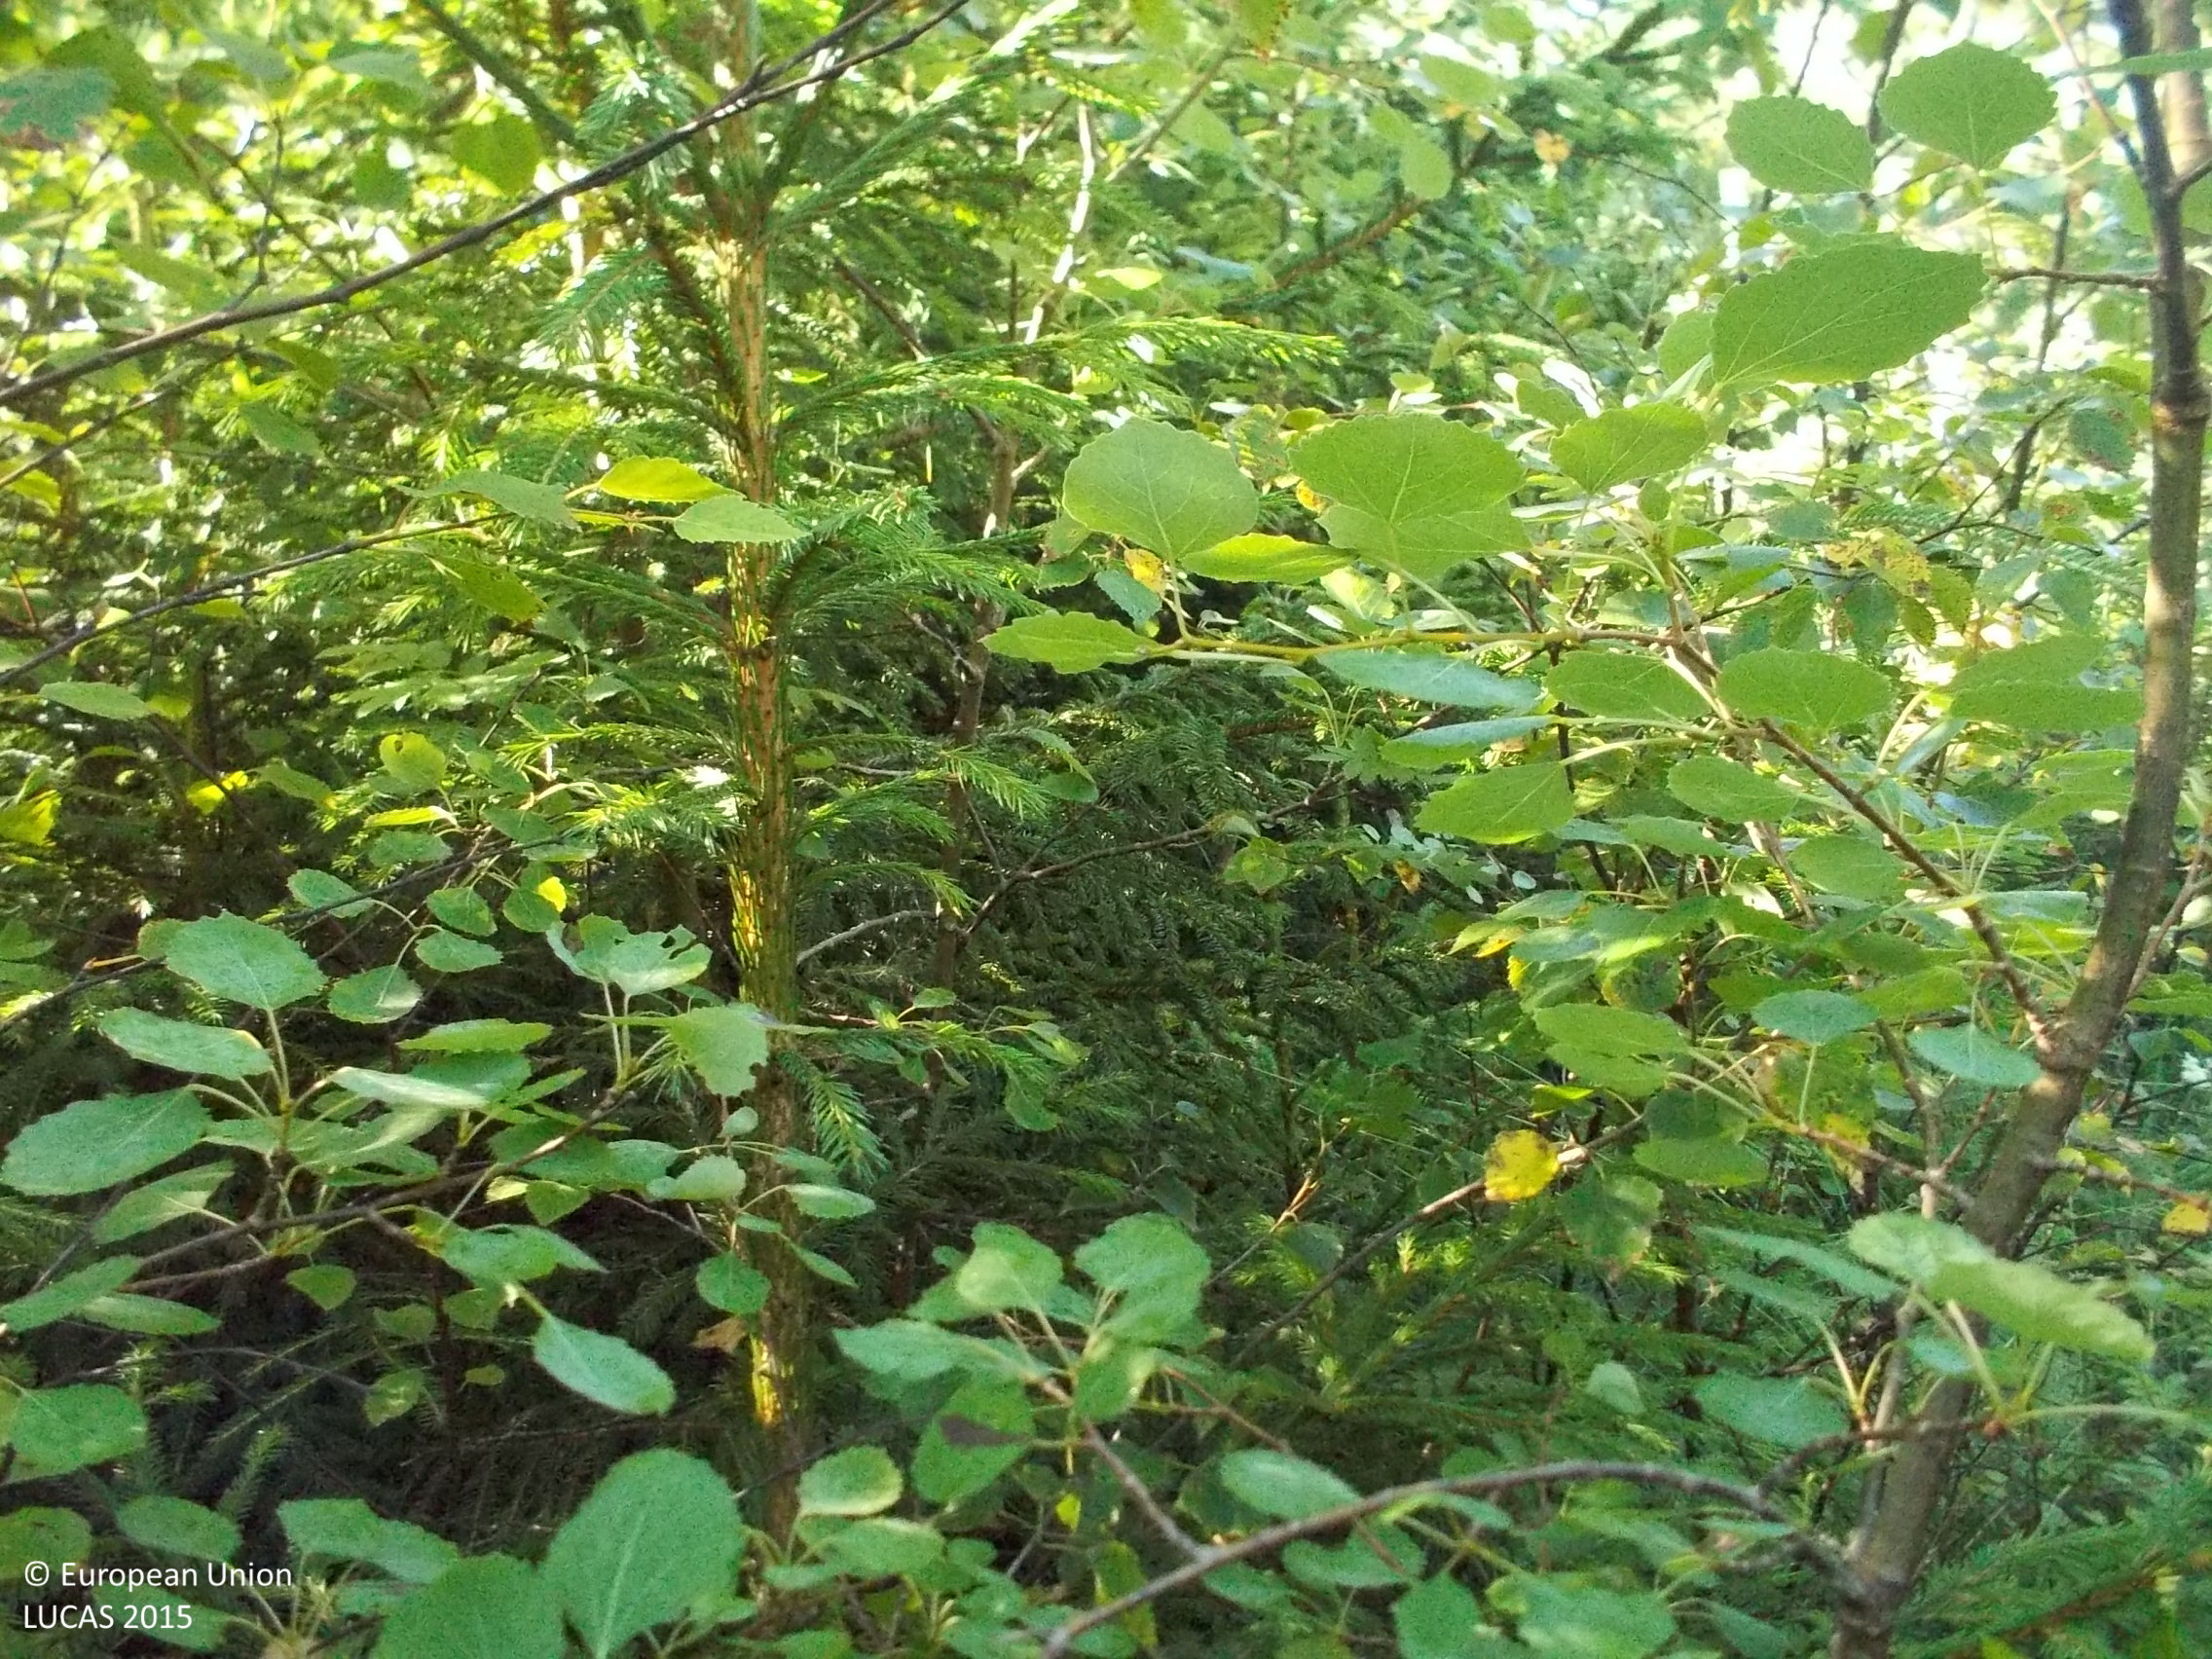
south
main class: Woodland
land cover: Spruce dominated mixed woodland
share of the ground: > 75 %
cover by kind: broadleaved forest trees 60 %, coniferous forest trees 30 %, herbaceous plants 10 %
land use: Forestry
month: August
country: SE
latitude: 57.5681
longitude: 13.2556
